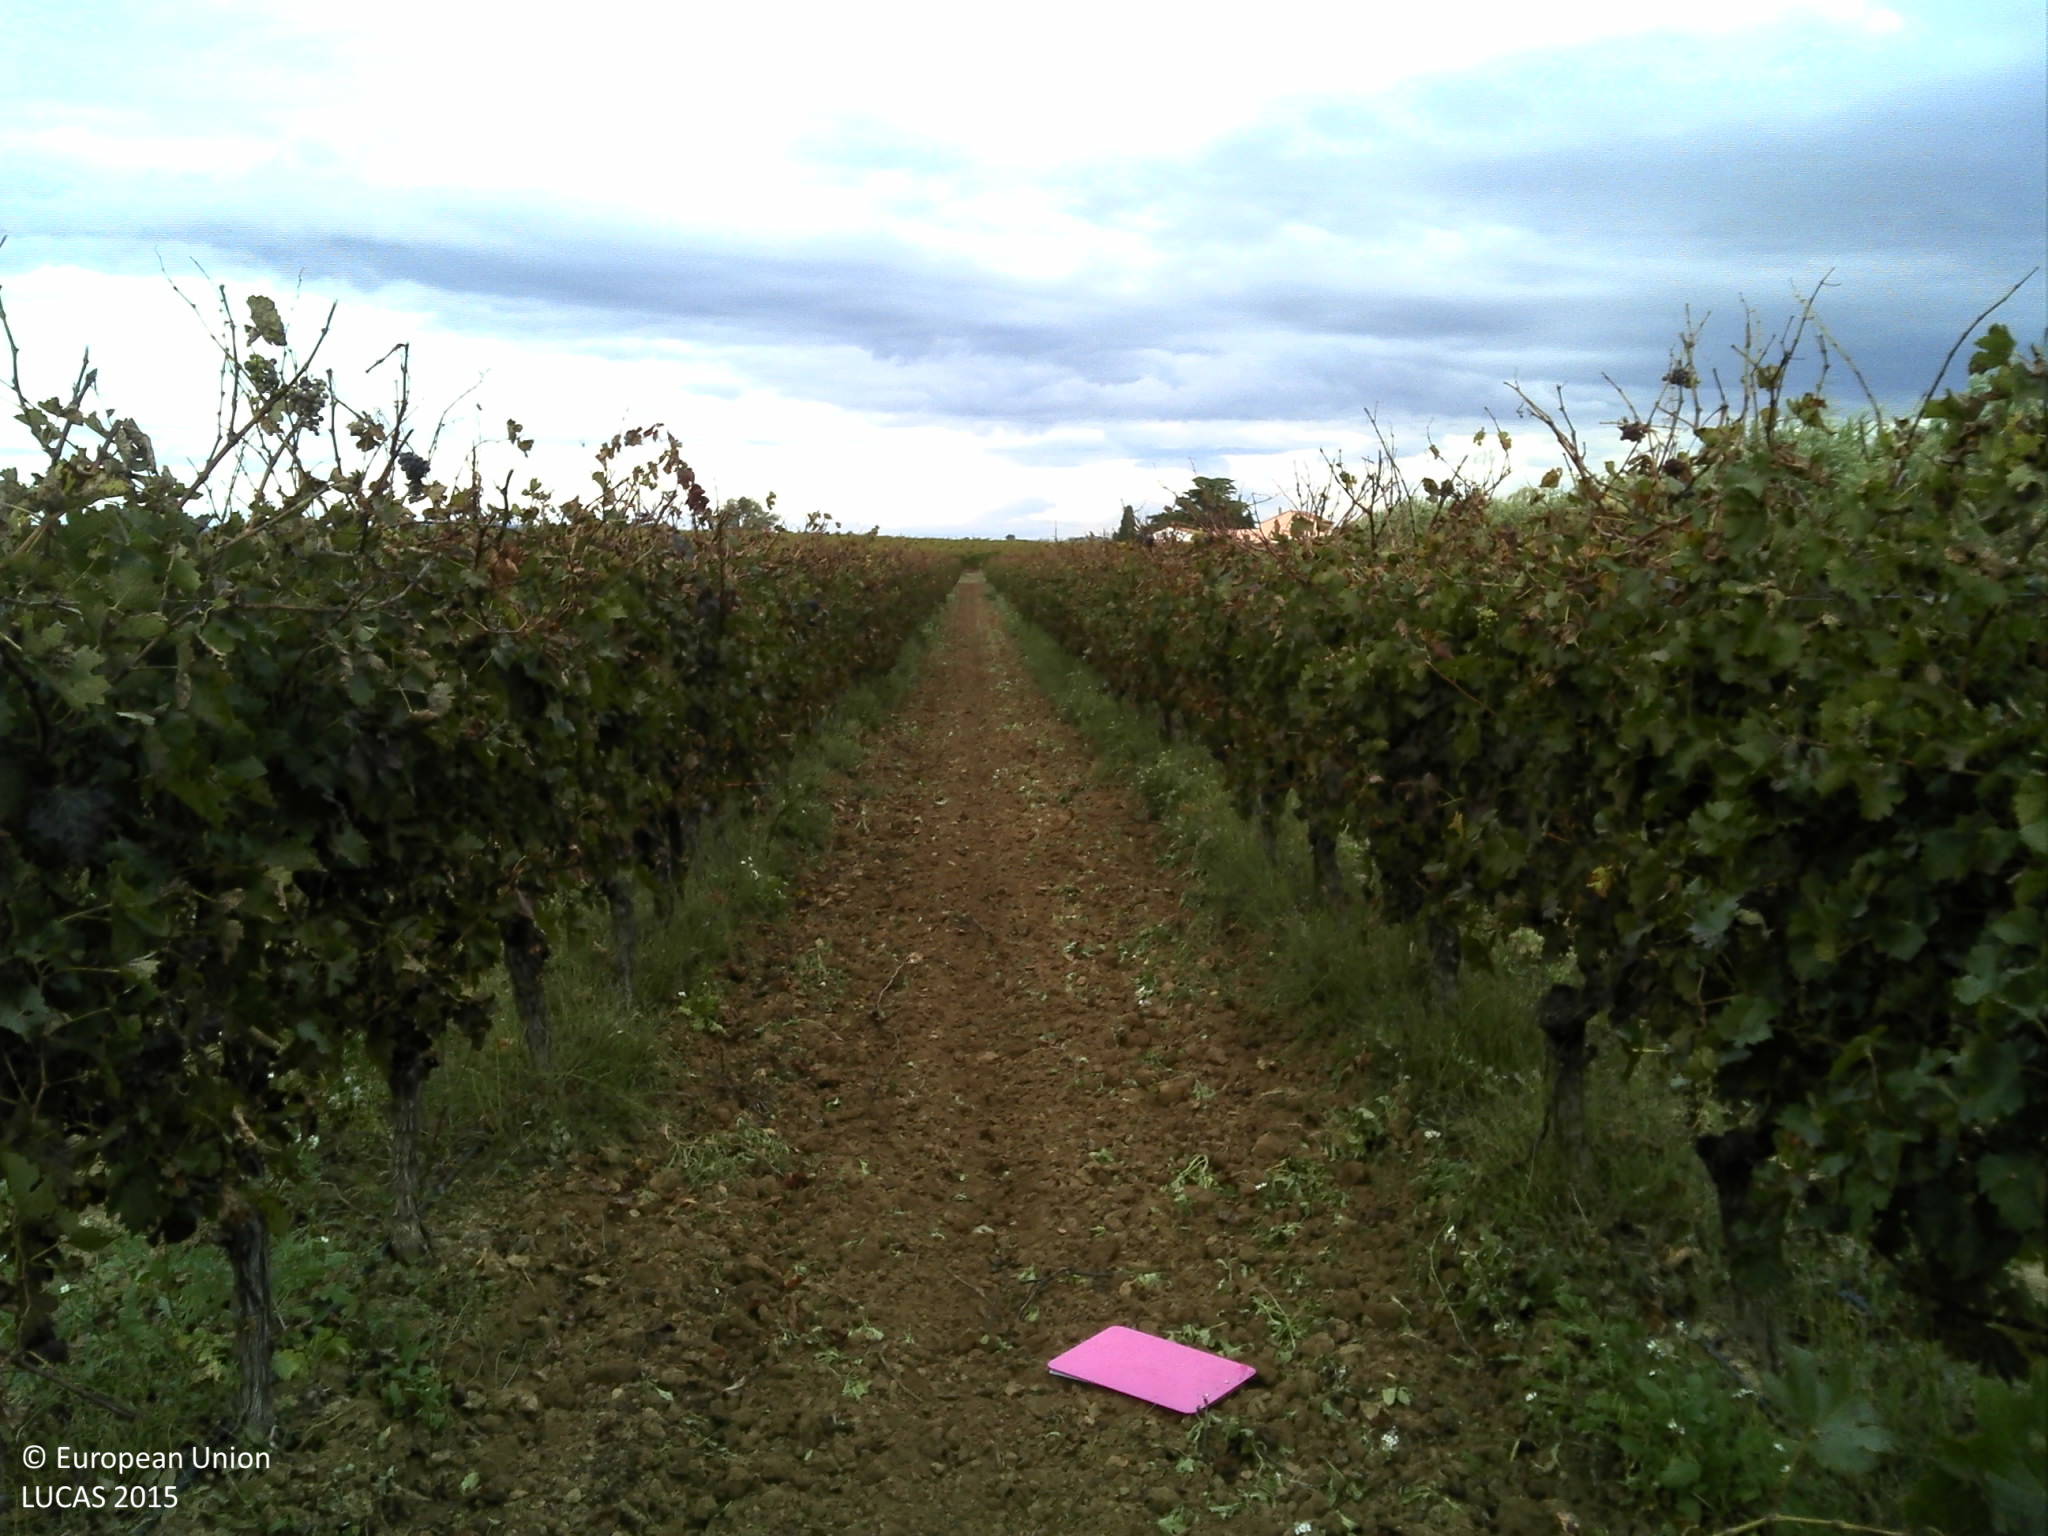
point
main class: Cropland
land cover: Vineyards
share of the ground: 10 - 25 %
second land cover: Other bare soil
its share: > 75 %
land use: Agriculture (excluding fallow land and kitchen gardens)
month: October
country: FR
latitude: 43.3596
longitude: 3.0870
